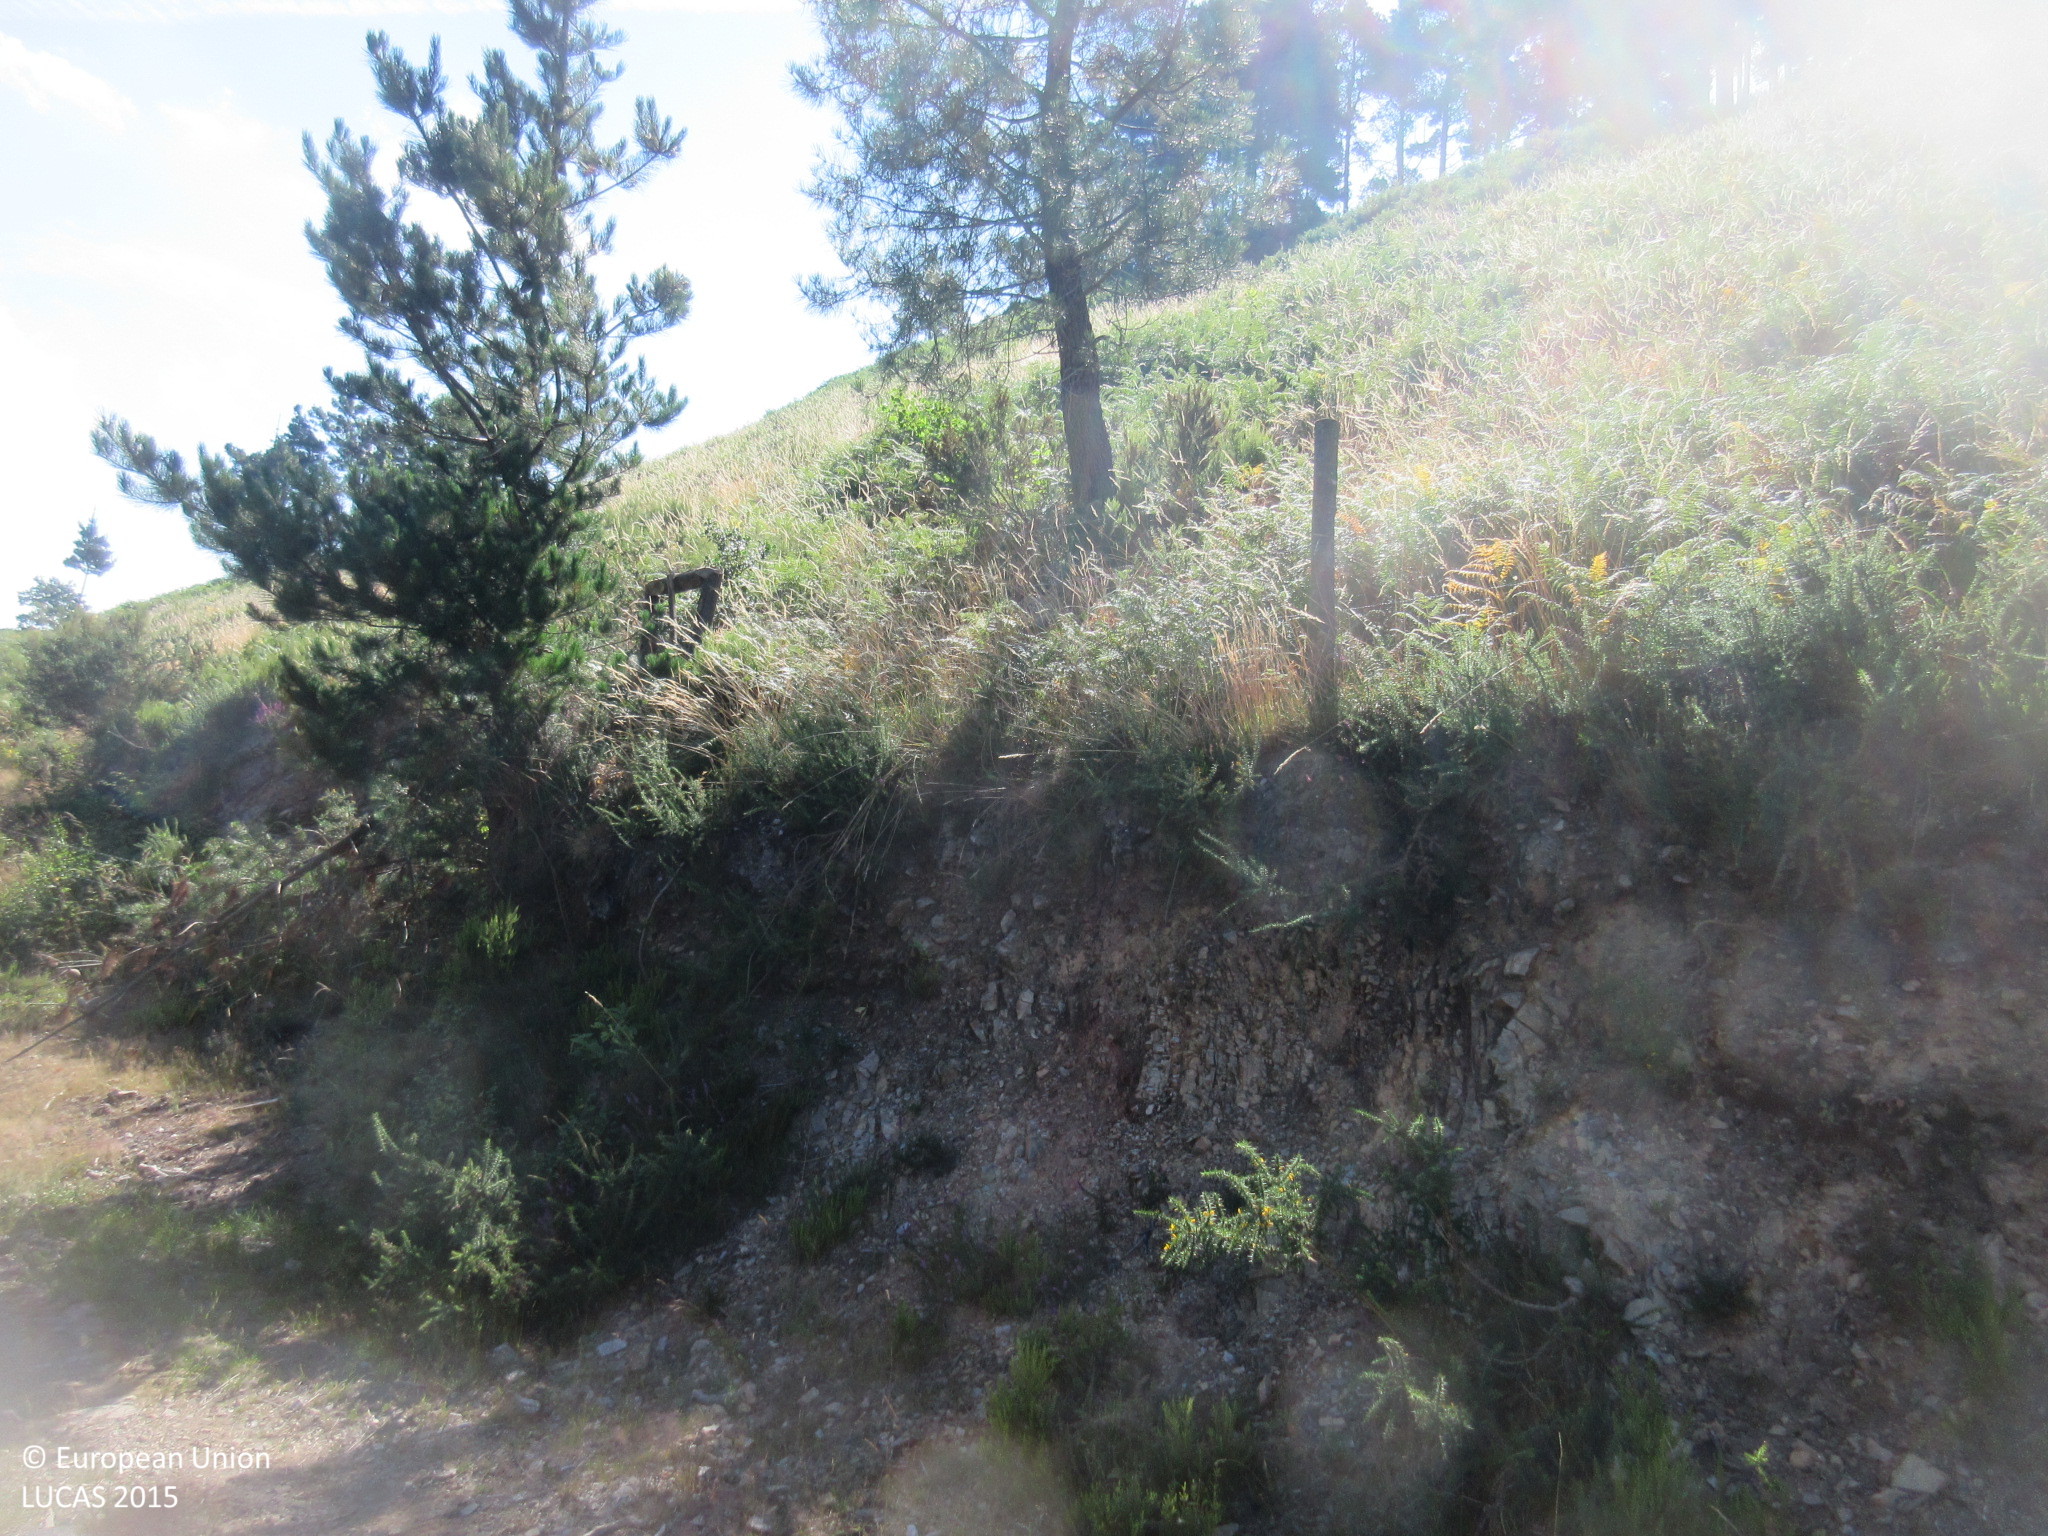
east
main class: Woodland
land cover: Broadleaved woodland
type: acidophilous oak and oak-birch forest
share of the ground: > 75 %
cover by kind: broadleaved forest trees 95 %, shrubs 5 %
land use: Forestry
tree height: > 5 m
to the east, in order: Broadleaved woodland; Shrubland without tree cover; Shrubland with sparse tree cover; Fences; Tracks
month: July
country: ES
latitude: 43.2733
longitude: -6.6282
